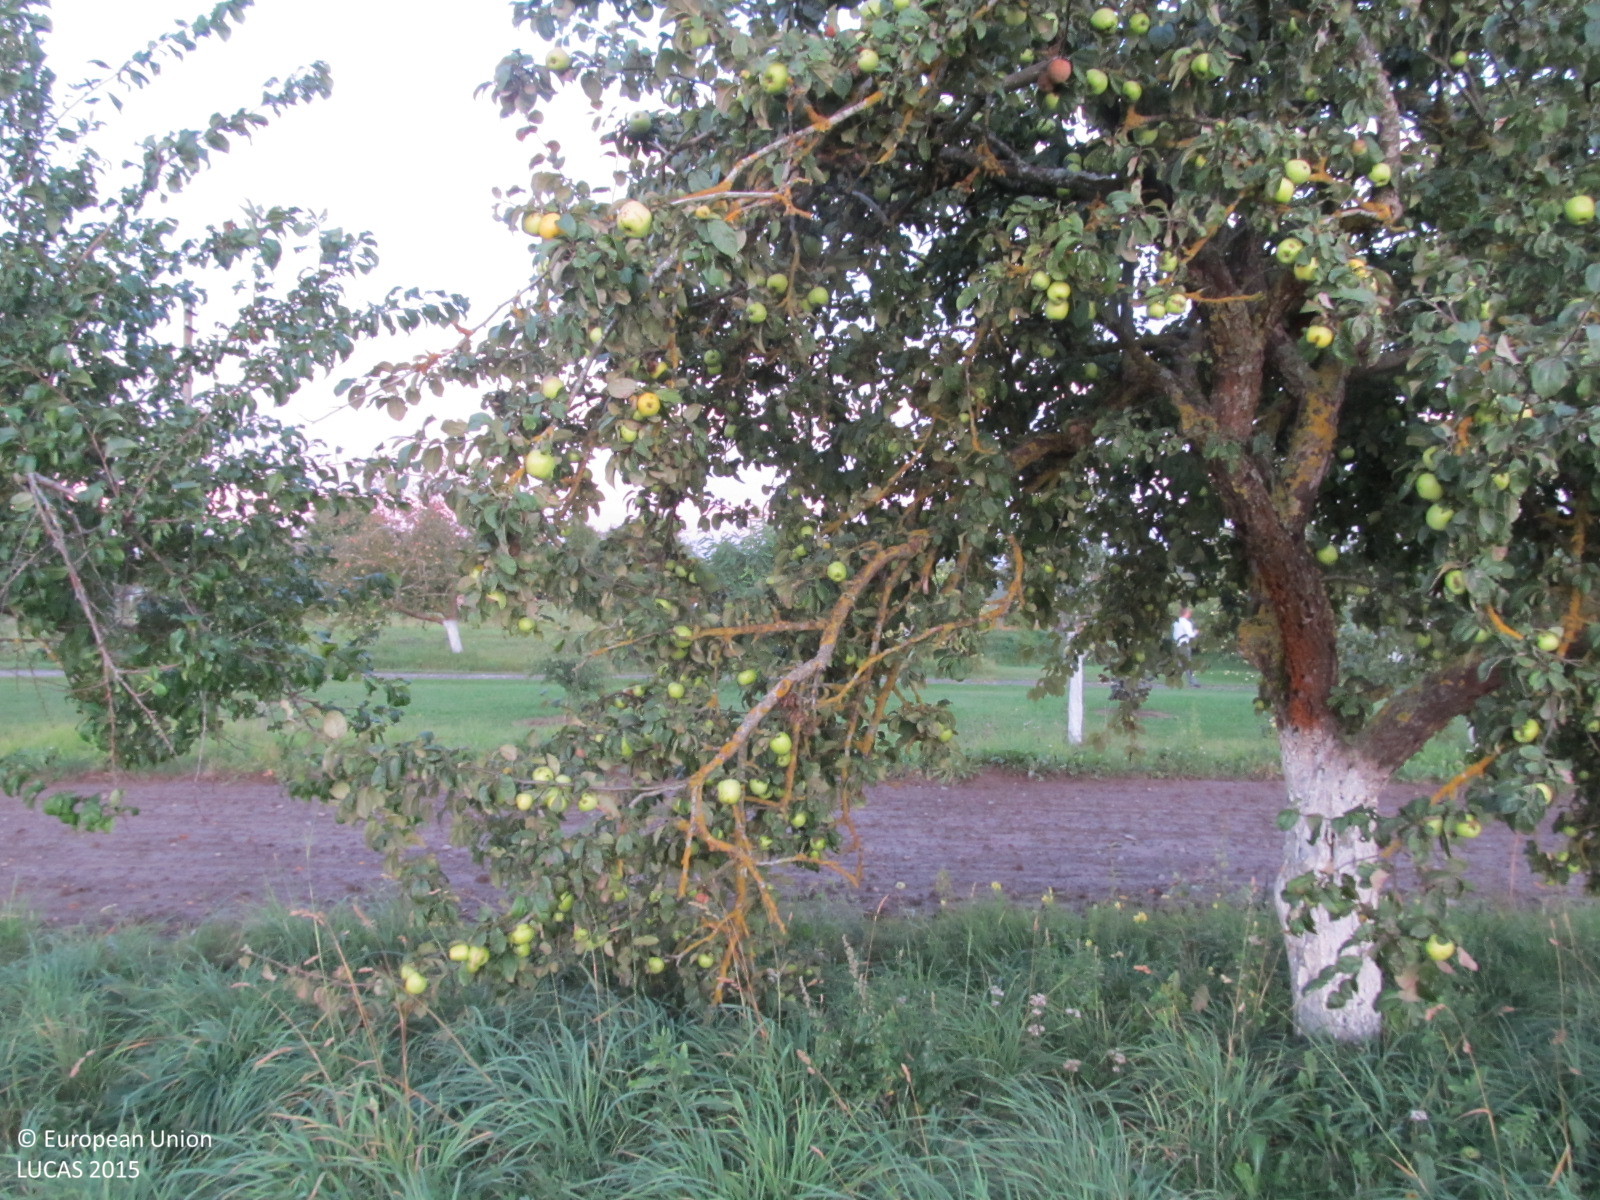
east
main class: Cropland
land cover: Apple fruit
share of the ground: 25 - 50 %
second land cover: Grassland without tree/shrub cover
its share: > 75 %
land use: Kitchen garden
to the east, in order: Apple fruit; Grassland without tree/shrub cover; Other bare soil; Apple fruit; Grassland without tree/shrub cover; Tracks; Grass margins; Lines of trees; Electric lines; Grassland without tree/shrub cover; Other fresh vegetables; Grassland without tree/shrub cover; Lines of trees; Artificial constructions in urban areas
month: September
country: LT
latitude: 55.9941
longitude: 22.4840
